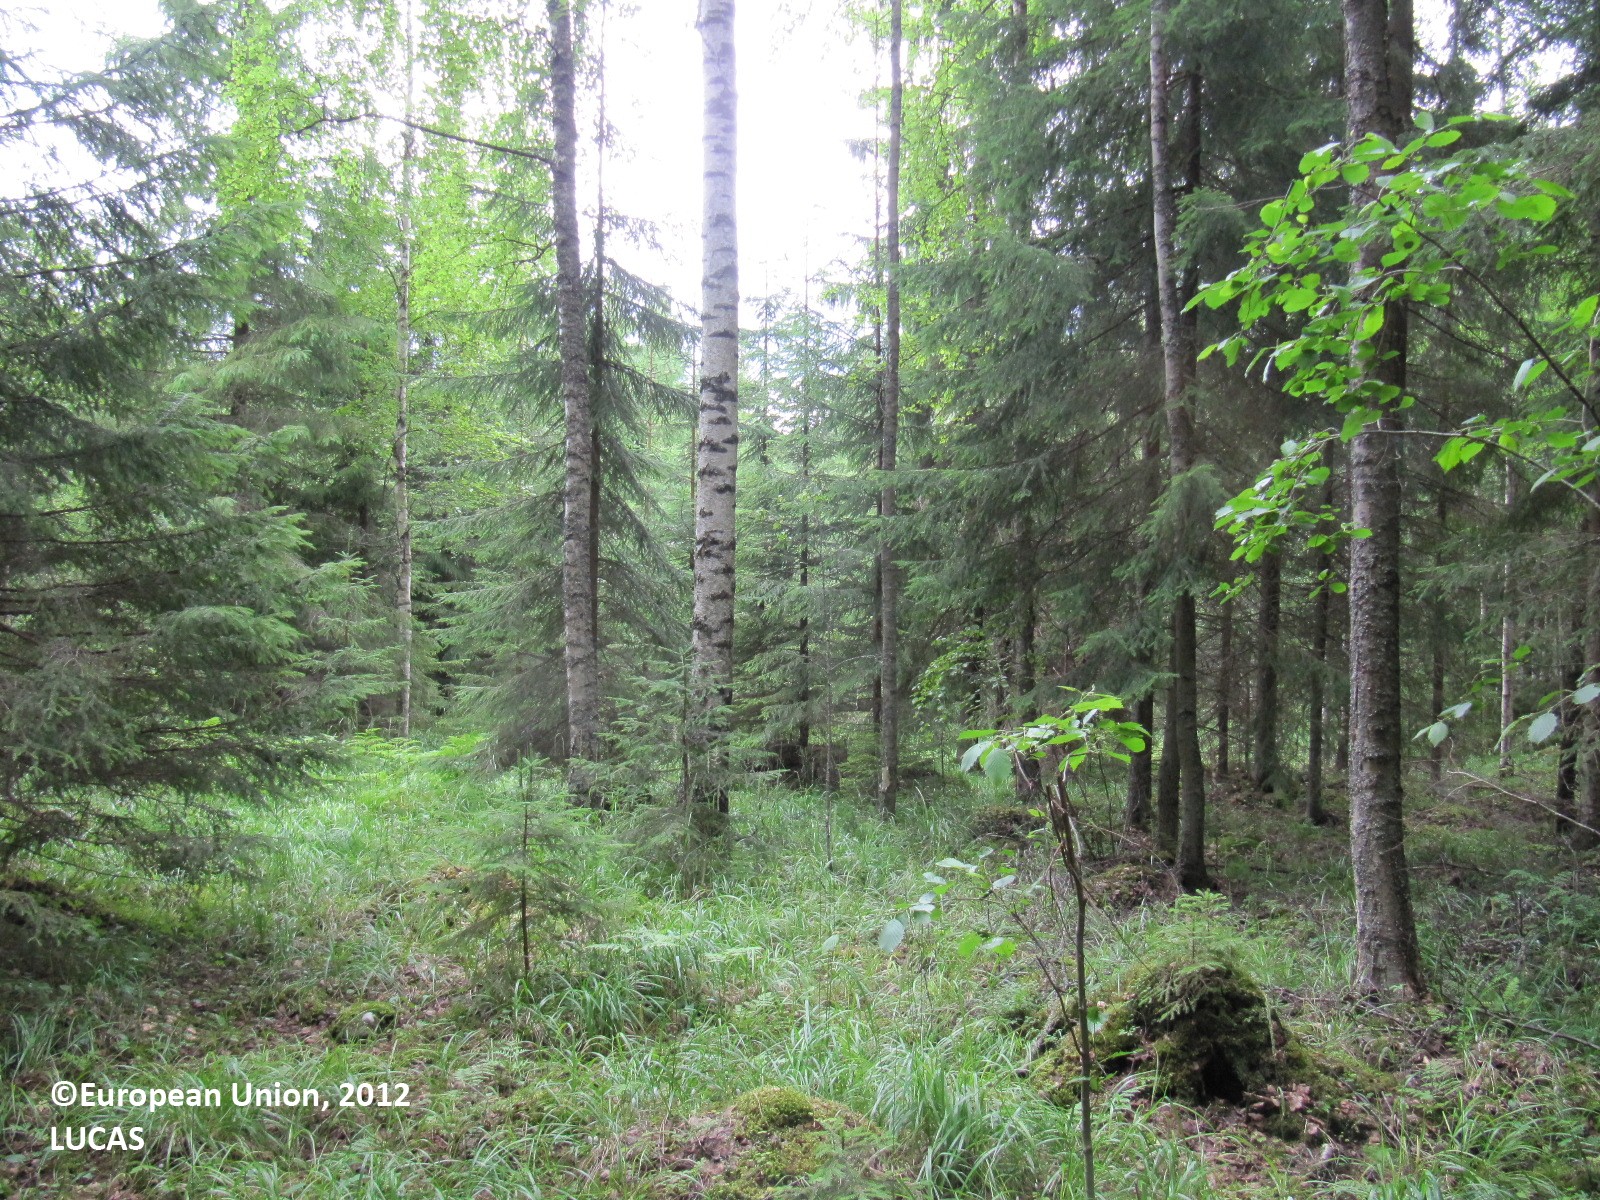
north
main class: Woodland
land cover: Spruce dominated mixed woodland
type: boreal forest
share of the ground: > 75 %
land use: Forestry
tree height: > 5 m
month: July
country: FI
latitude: 60.8309
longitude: 24.5810
